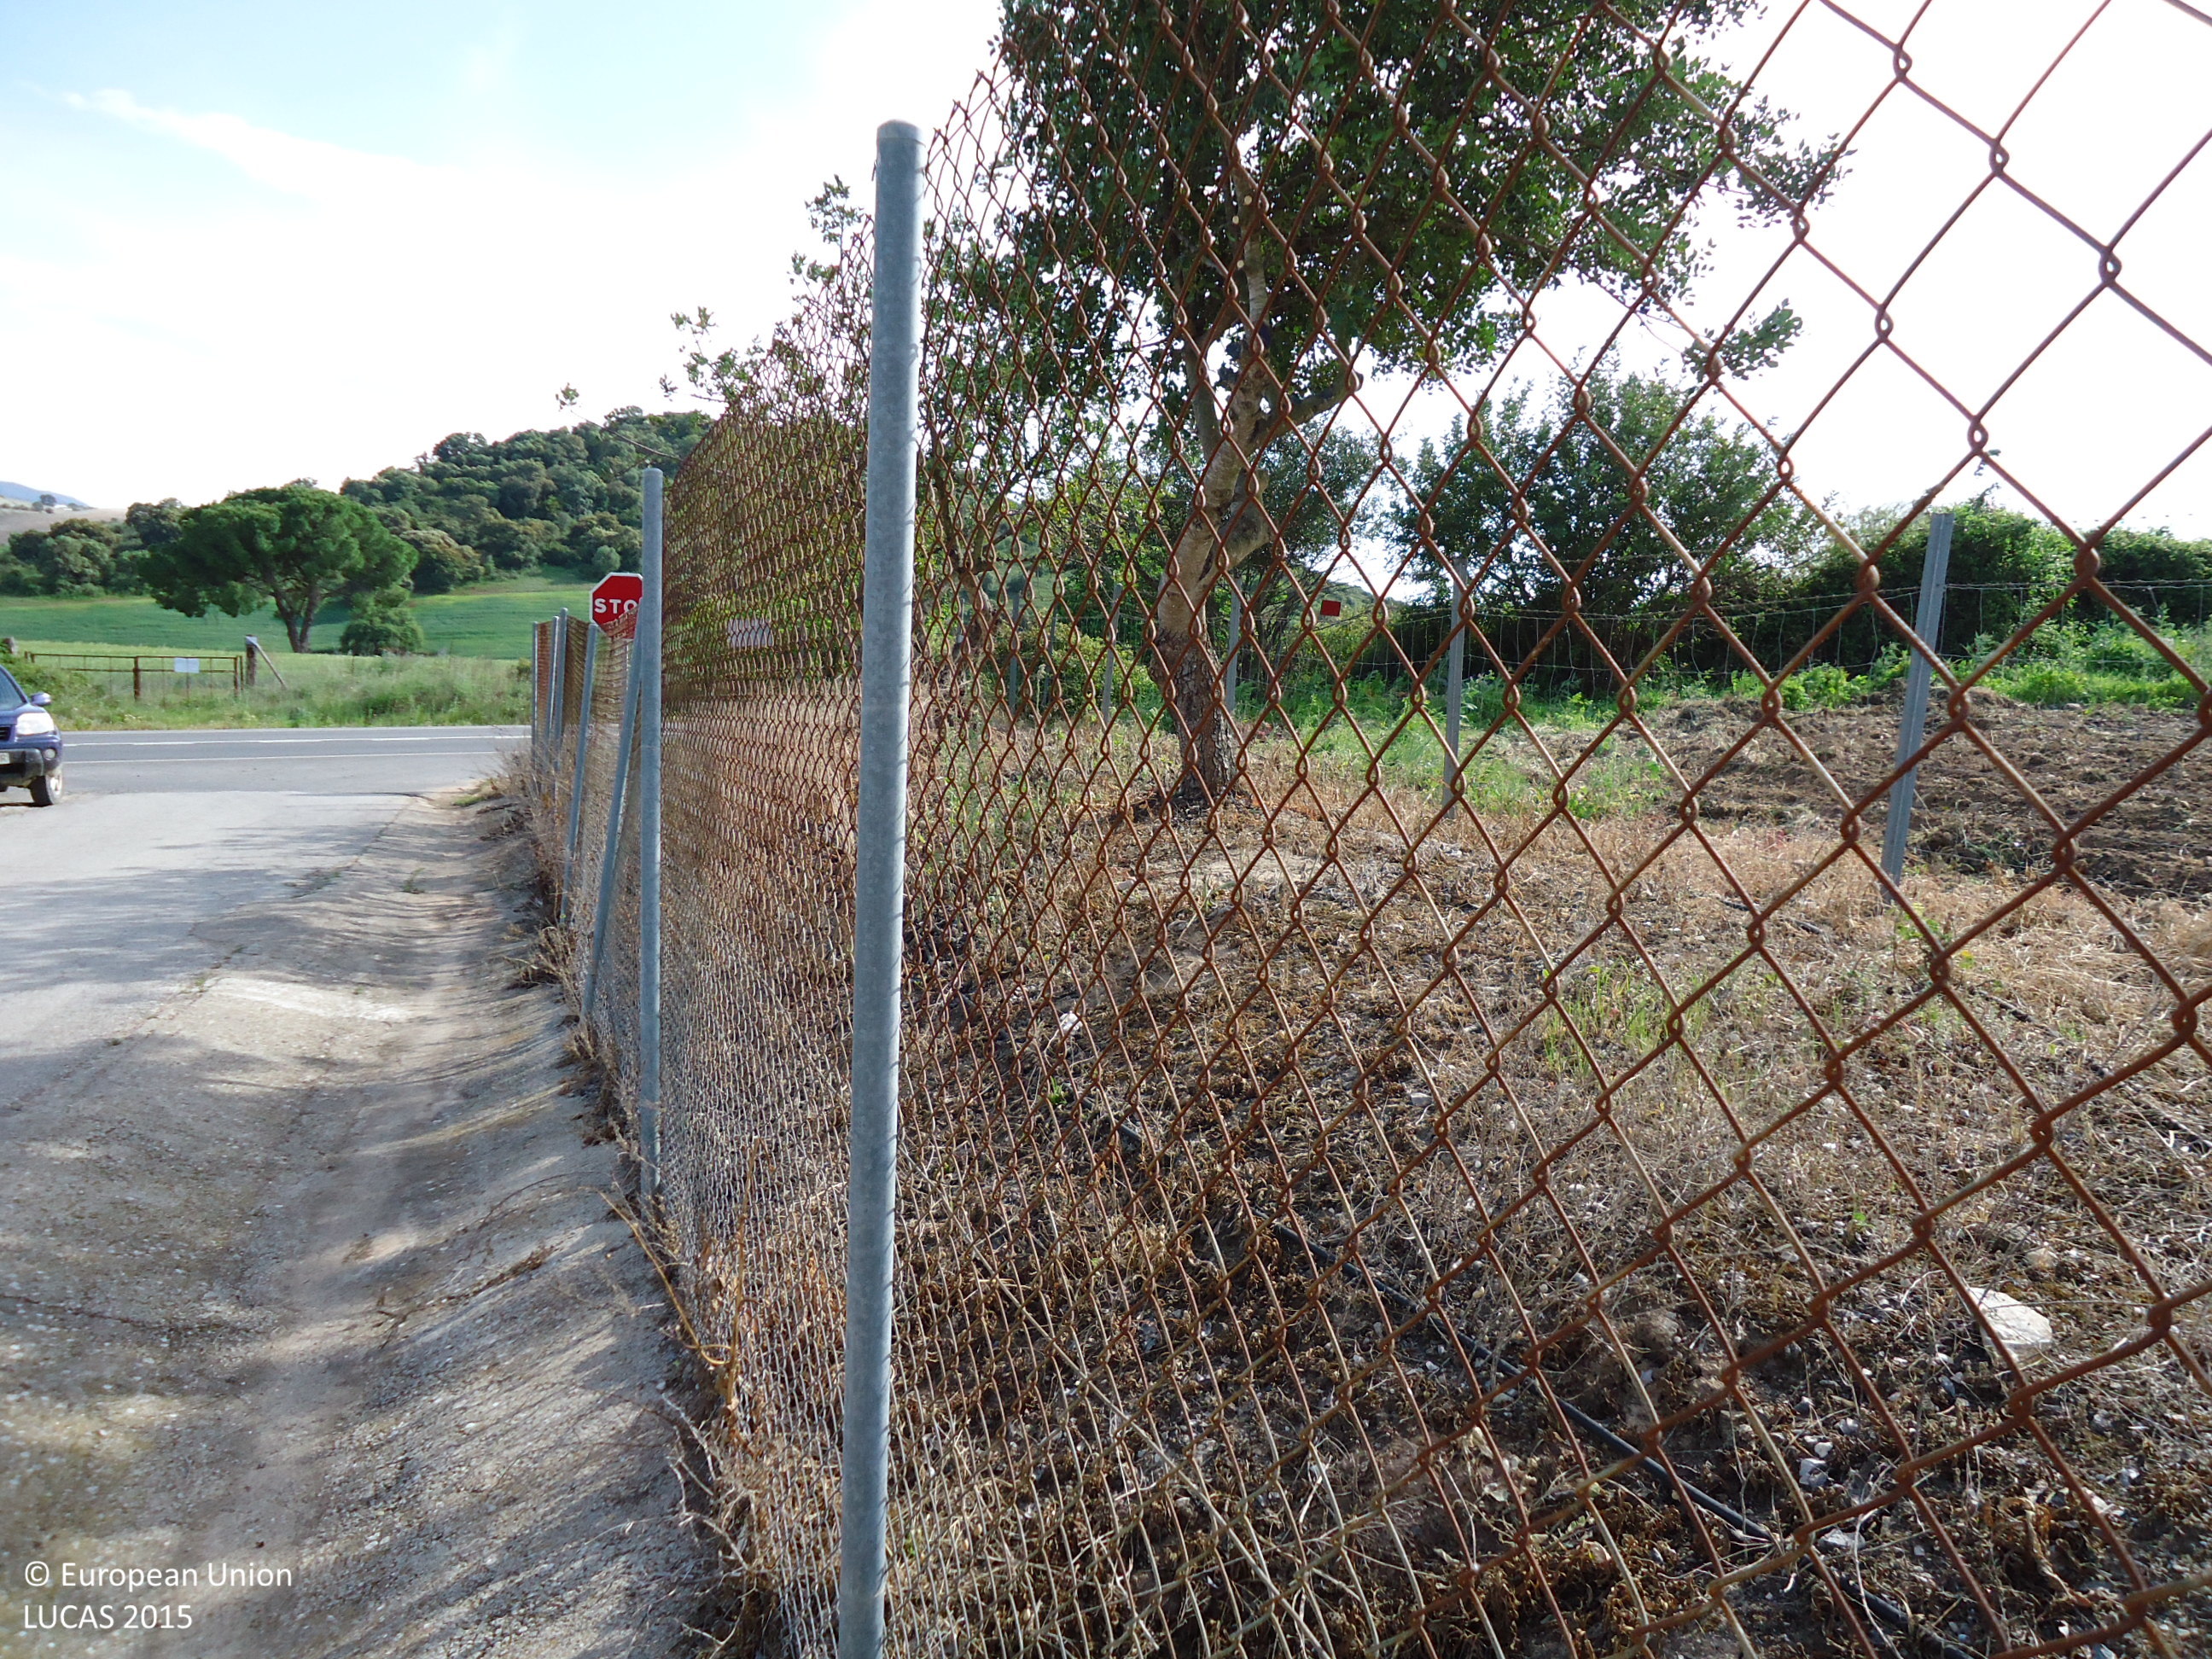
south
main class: Grassland
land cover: Spontaneously vegetated surfaces
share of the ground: > 75 %
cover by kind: herbaceous plants 100 %
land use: Fallow land
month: April
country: ES
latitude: 36.8952
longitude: -5.4811
